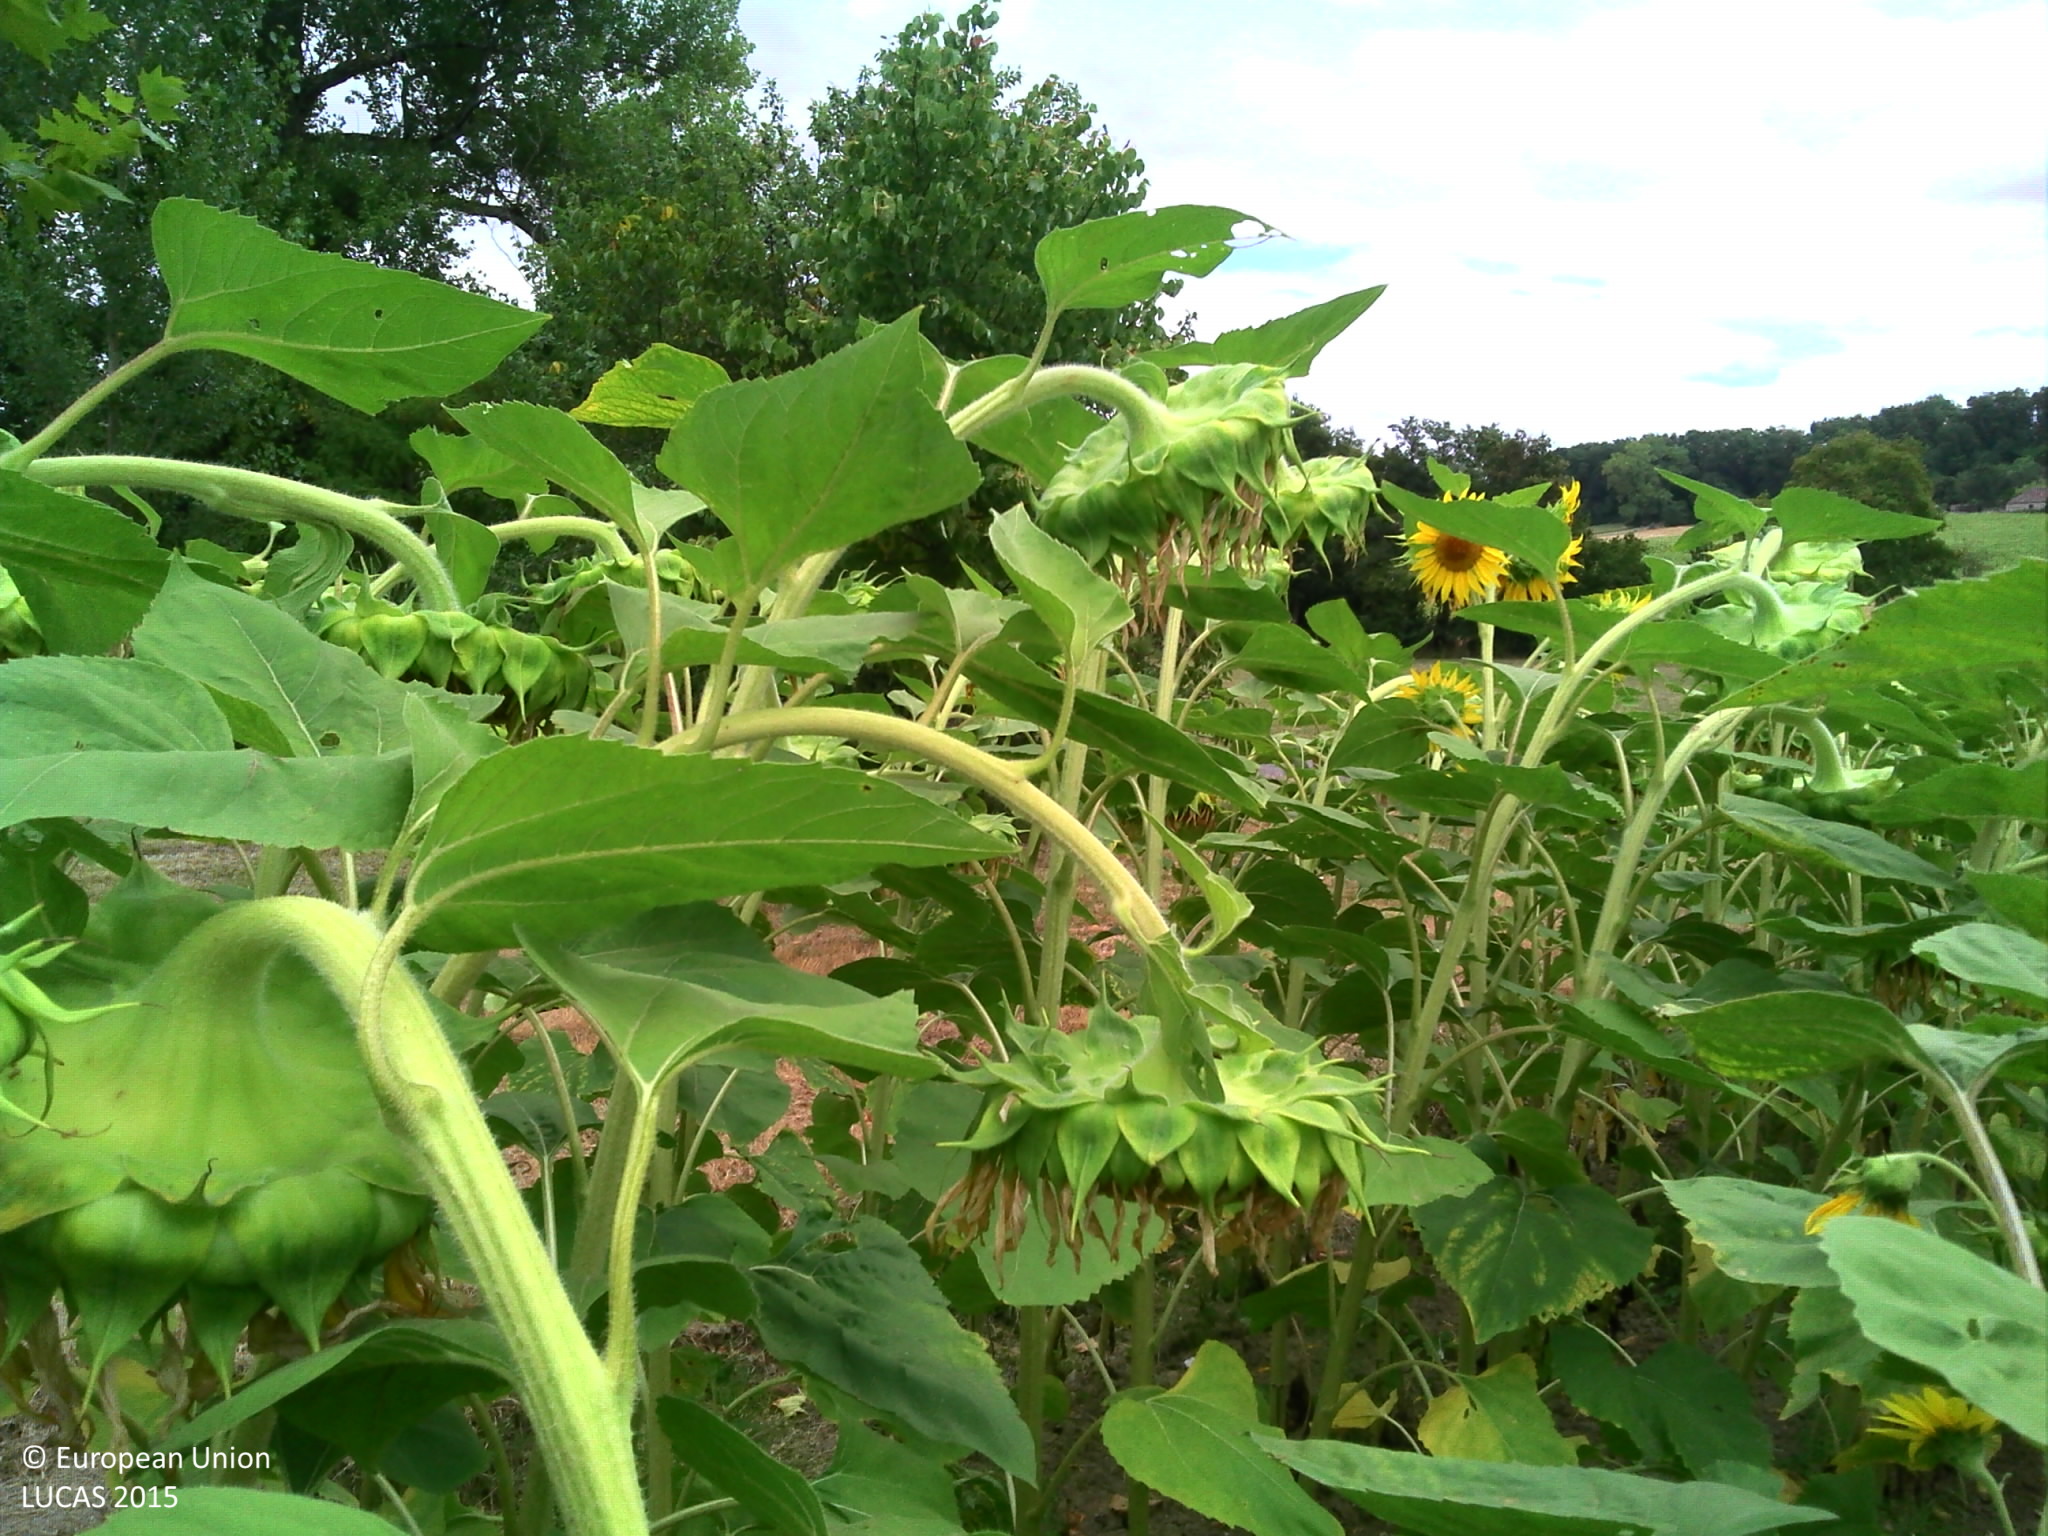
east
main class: Cropland
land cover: Sunflower
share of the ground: > 75 %
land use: Agriculture (excluding fallow land and kitchen gardens)
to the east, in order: Sunflower; Grass margins; Paved roads, cycling and walking lanes; Grass margins; Ditches and canals; Grassland without tree/shrub cover; Ditches and canals; Abandoned hedges; Fences; Grassland without tree/shrub cover; Broadleaved woodland; Rivers and streams; Broadleaved woodland; Grassland without tree/shrub cover; Broadleaved woodland; Rivers and streams; Broadleaved woodland; Tracks; Sunflower
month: July
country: FR
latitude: 44.3023
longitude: 0.5803
